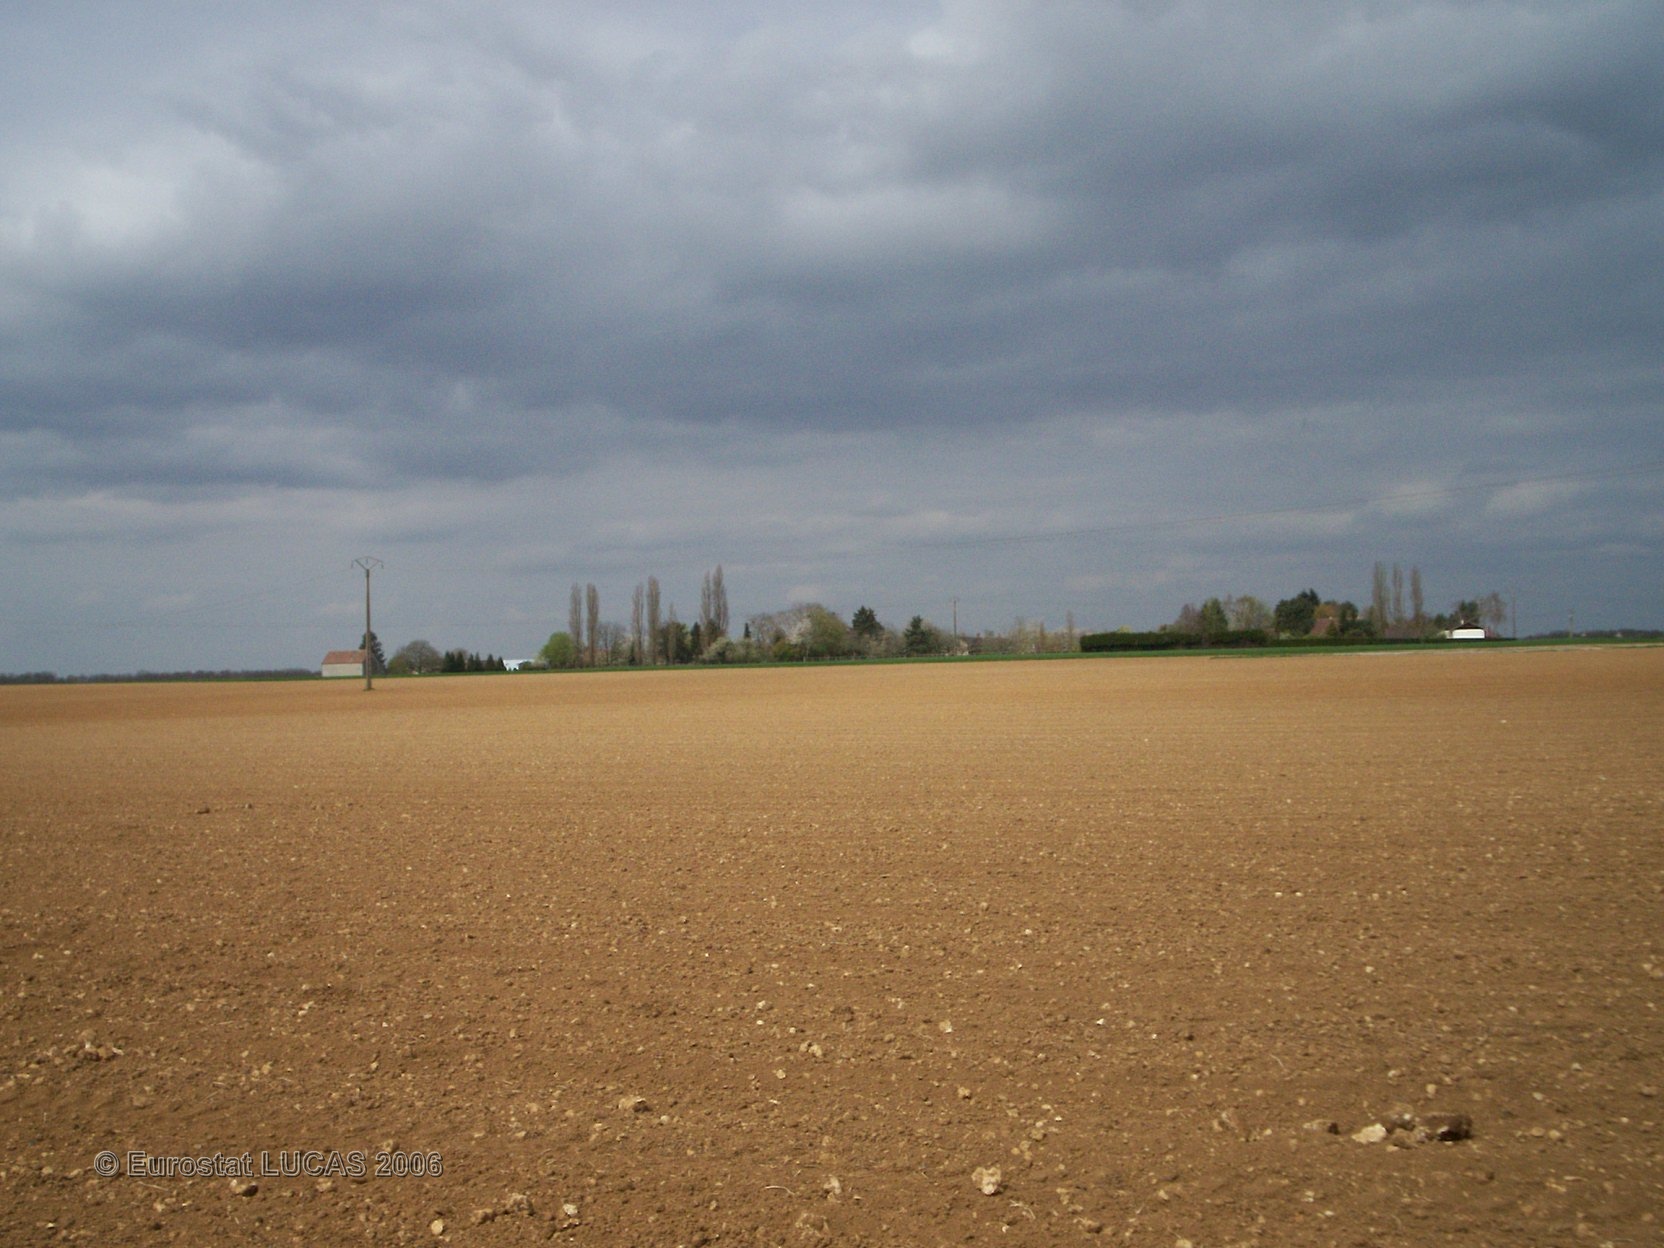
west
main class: Cropland
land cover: Sugar beet
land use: Agriculture (excluding fallow land and kitchen gardens)
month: April
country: FR
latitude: 48.2471
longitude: 2.8948
